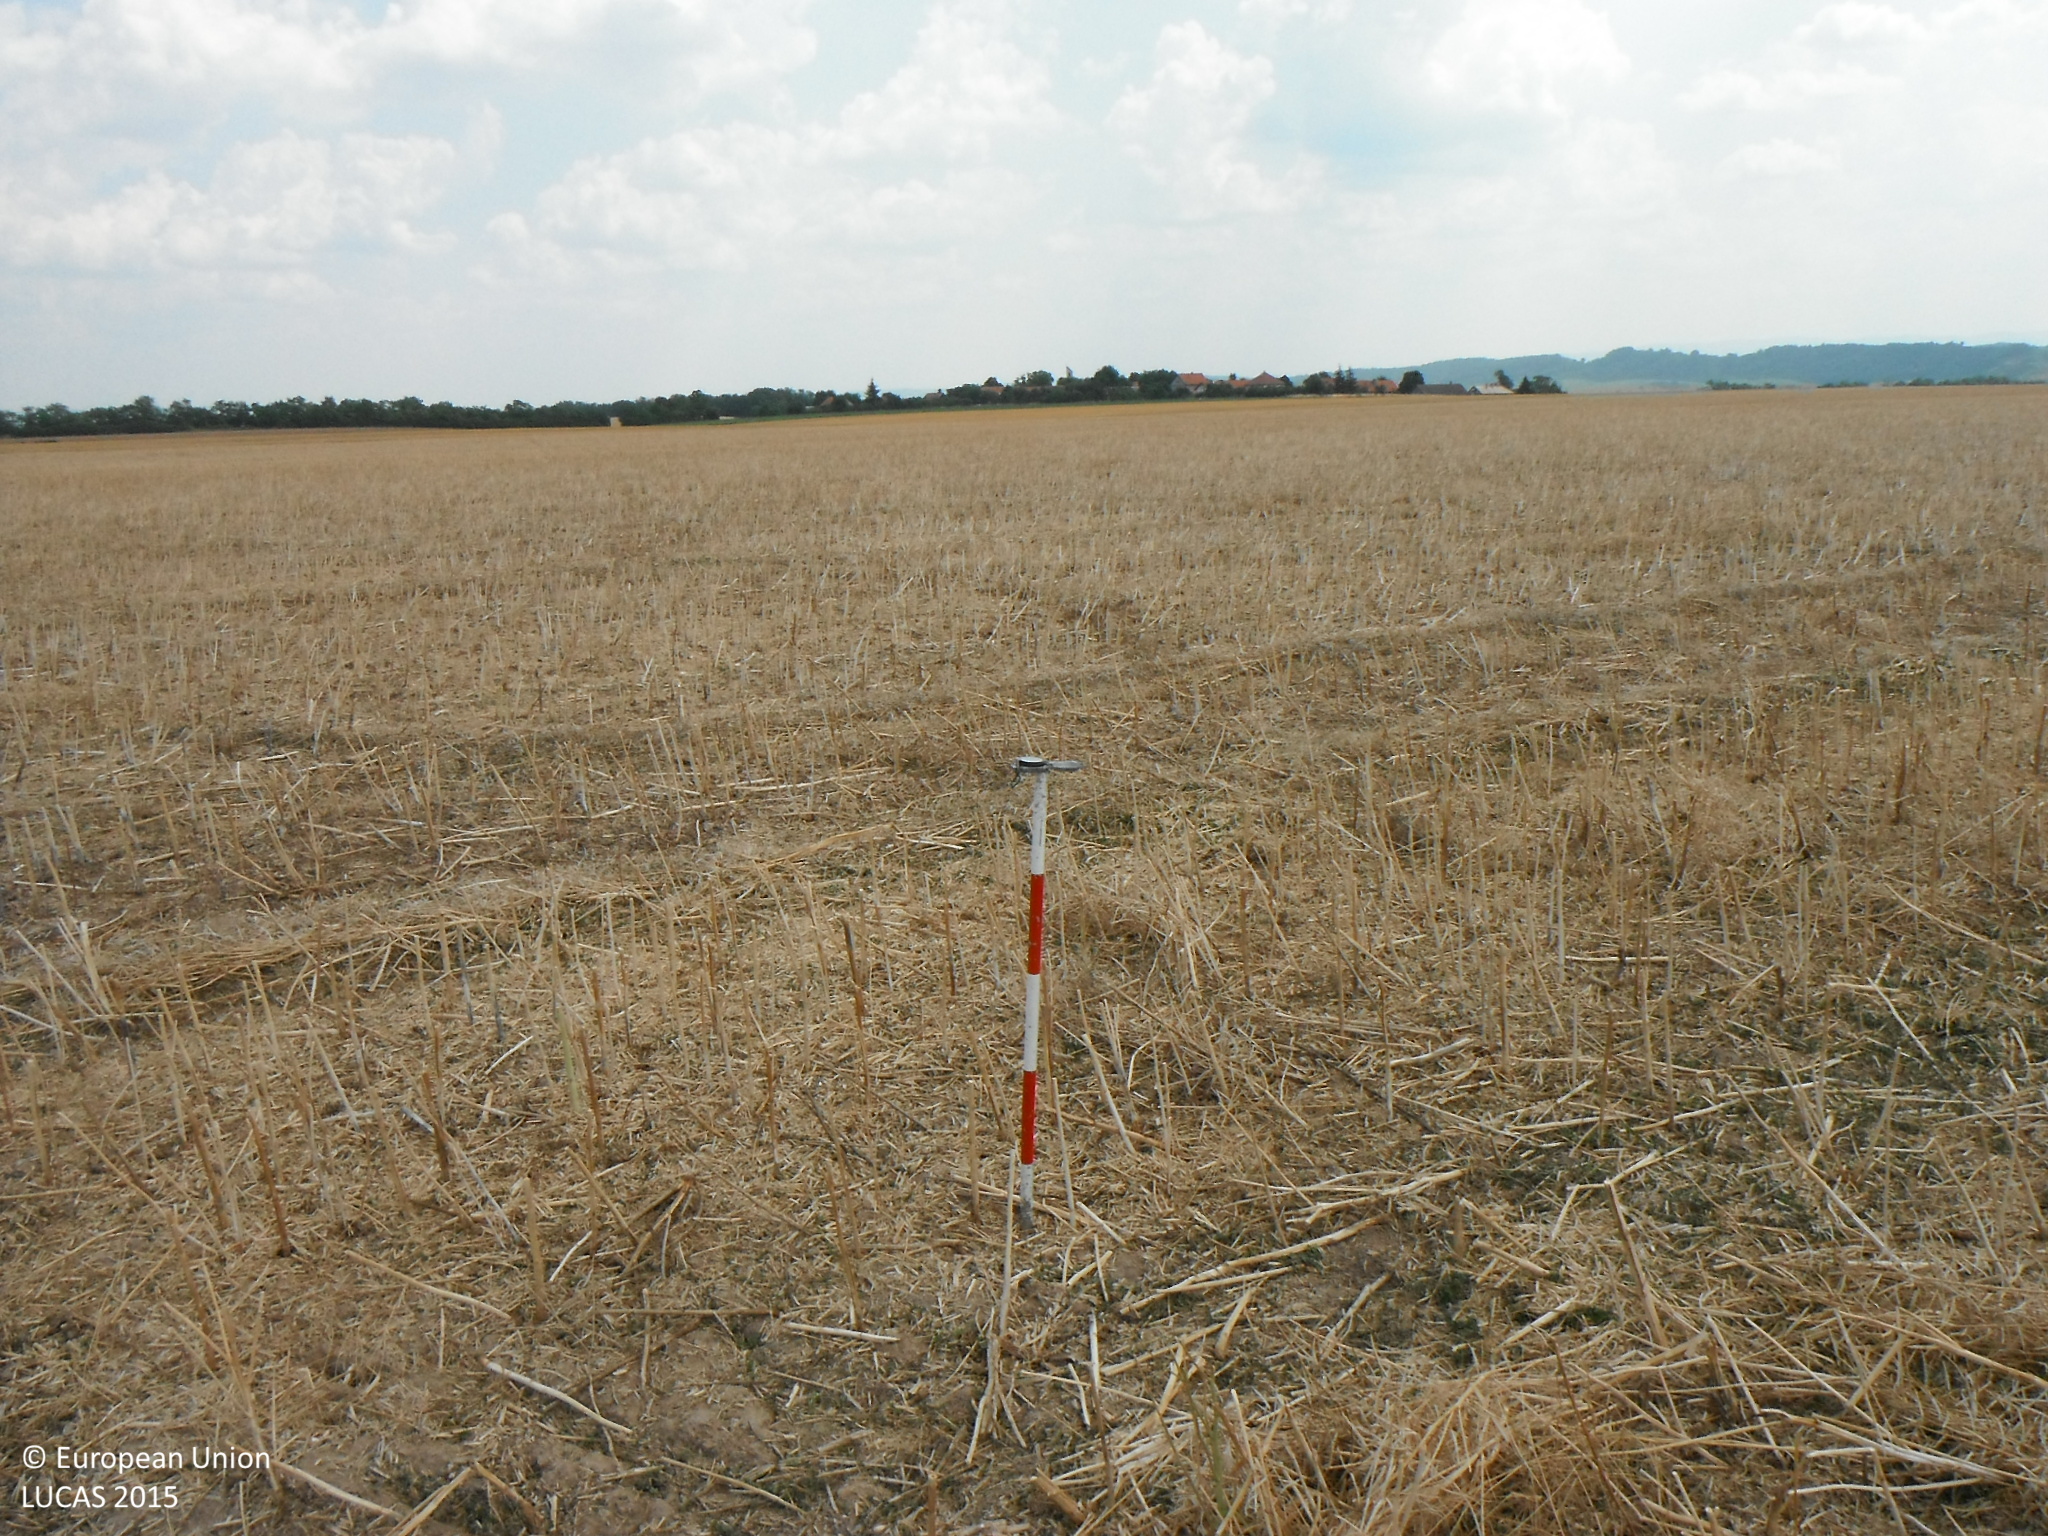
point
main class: Cropland
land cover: Rape and turnip rape
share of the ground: > 75 %
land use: Agriculture (excluding fallow land and kitchen gardens)
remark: Harvested field
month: July
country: SK
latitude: 48.3128
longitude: 20.1844
